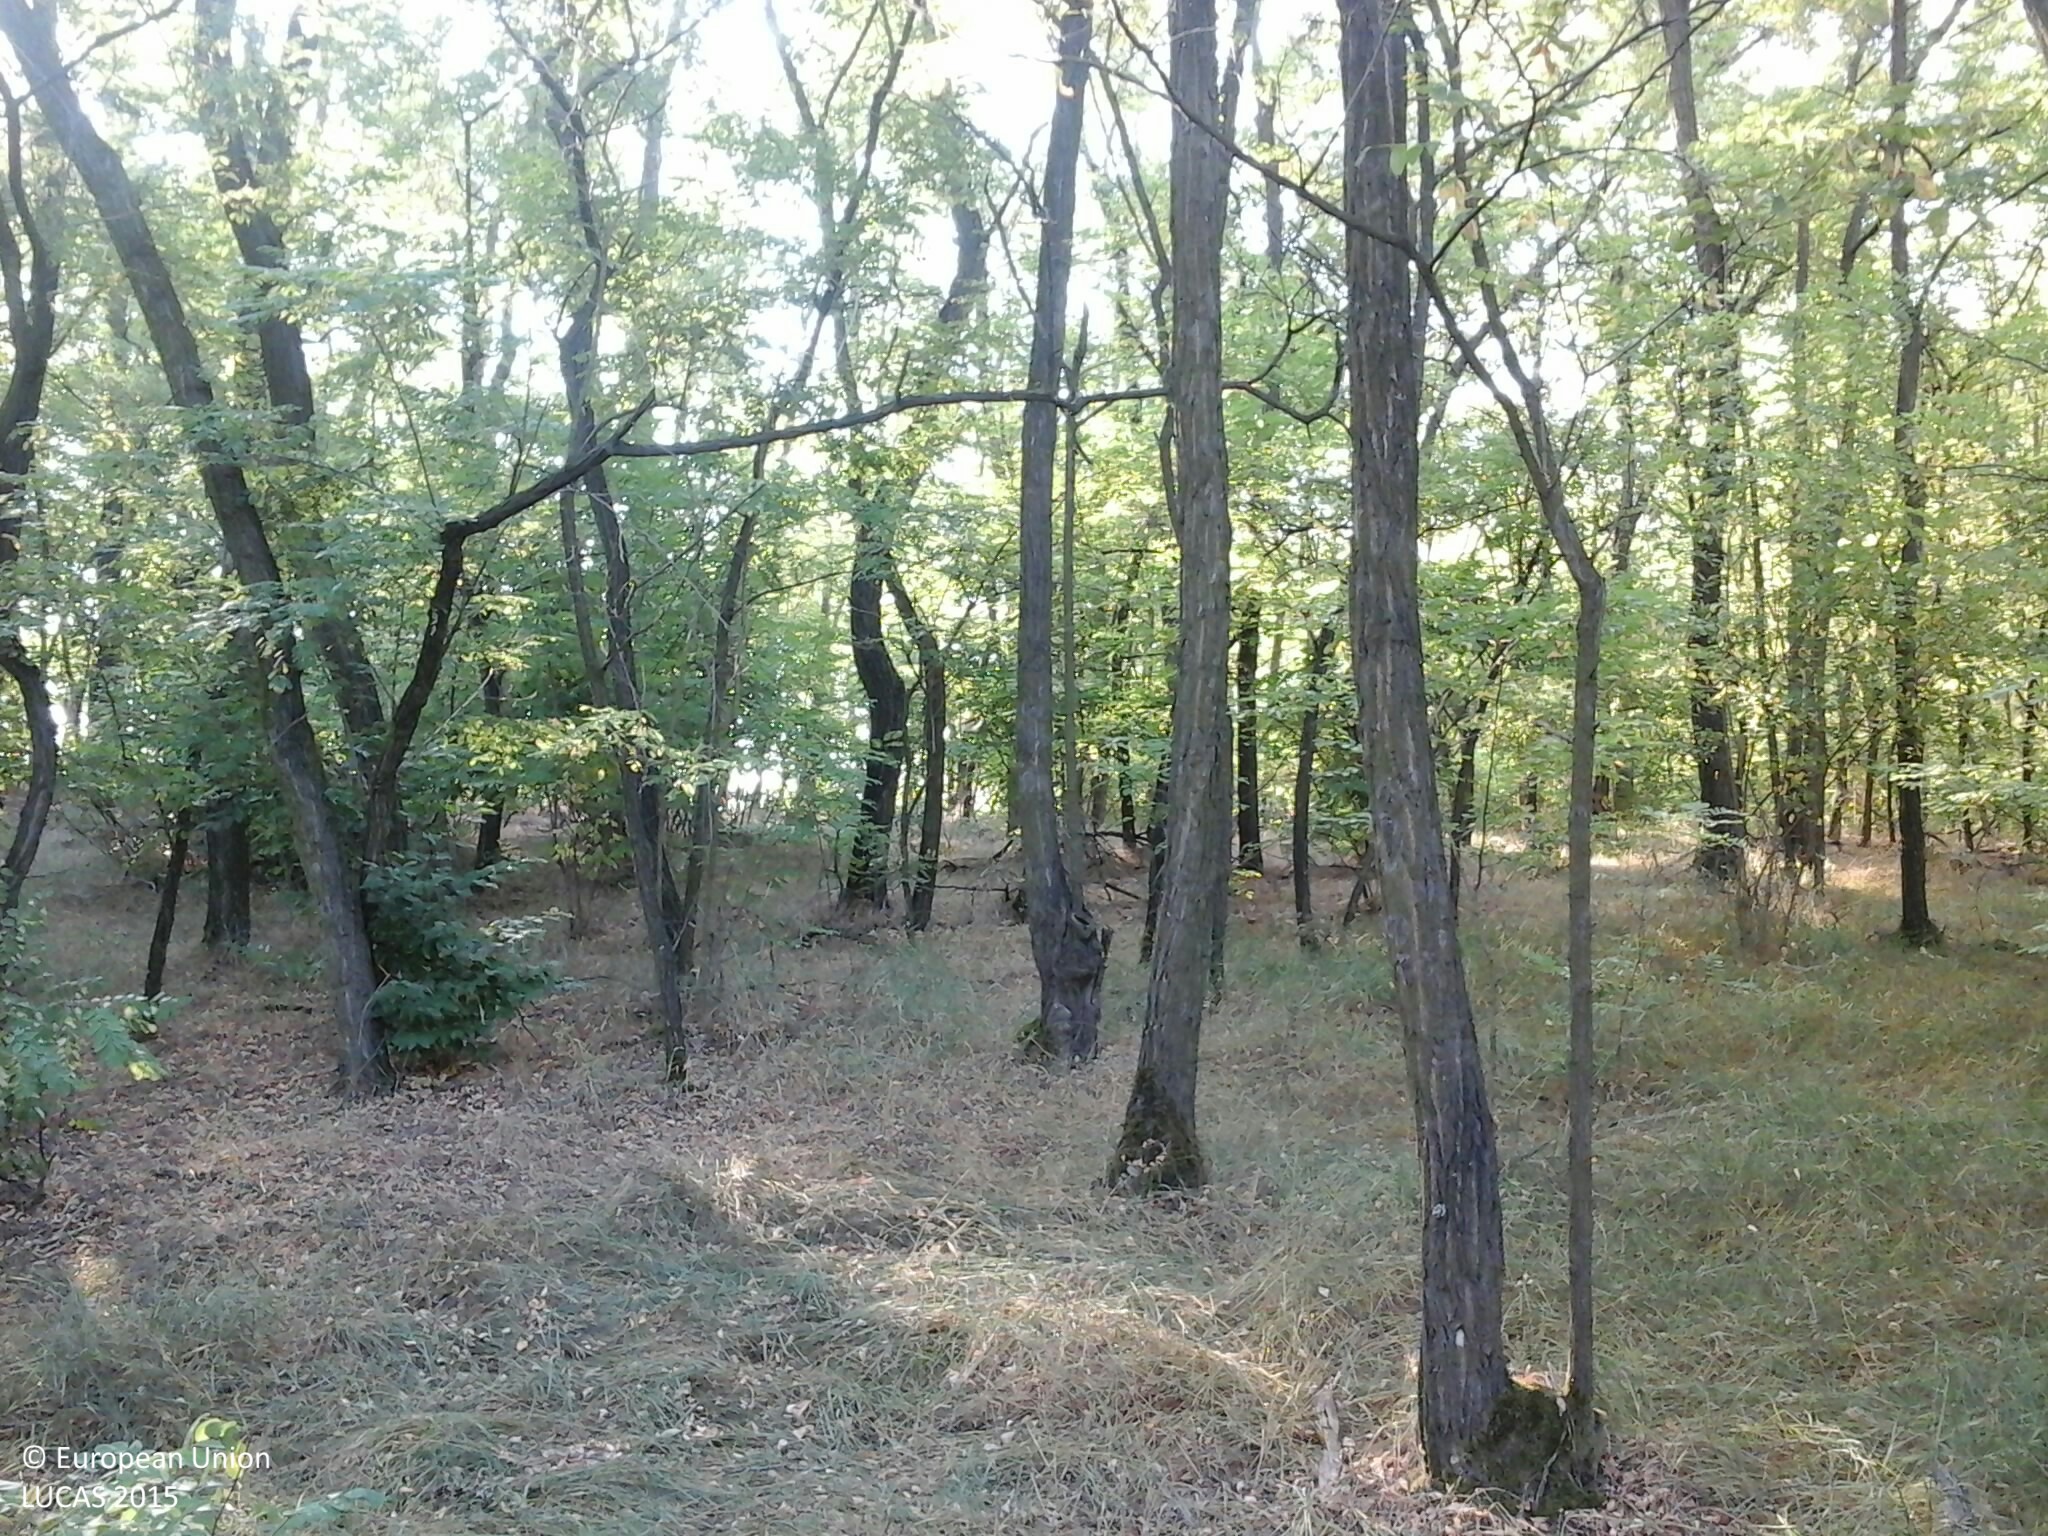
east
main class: Woodland
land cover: Broadleaved woodland
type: exotic forest
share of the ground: > 75 %
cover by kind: broadleaved forest trees 80 %, herbaceous plants 15 %, shrubs 5 %
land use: Forestry
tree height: > 5 m
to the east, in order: Broadleaved woodland; Tracks; Broadleaved woodland; Grassland with sparse tree/shrub cover; Grassland without tree/shrub cover; Ditches and canals; Grassland without tree/shrub cover
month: July
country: HU
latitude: 47.6630
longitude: 22.1032
